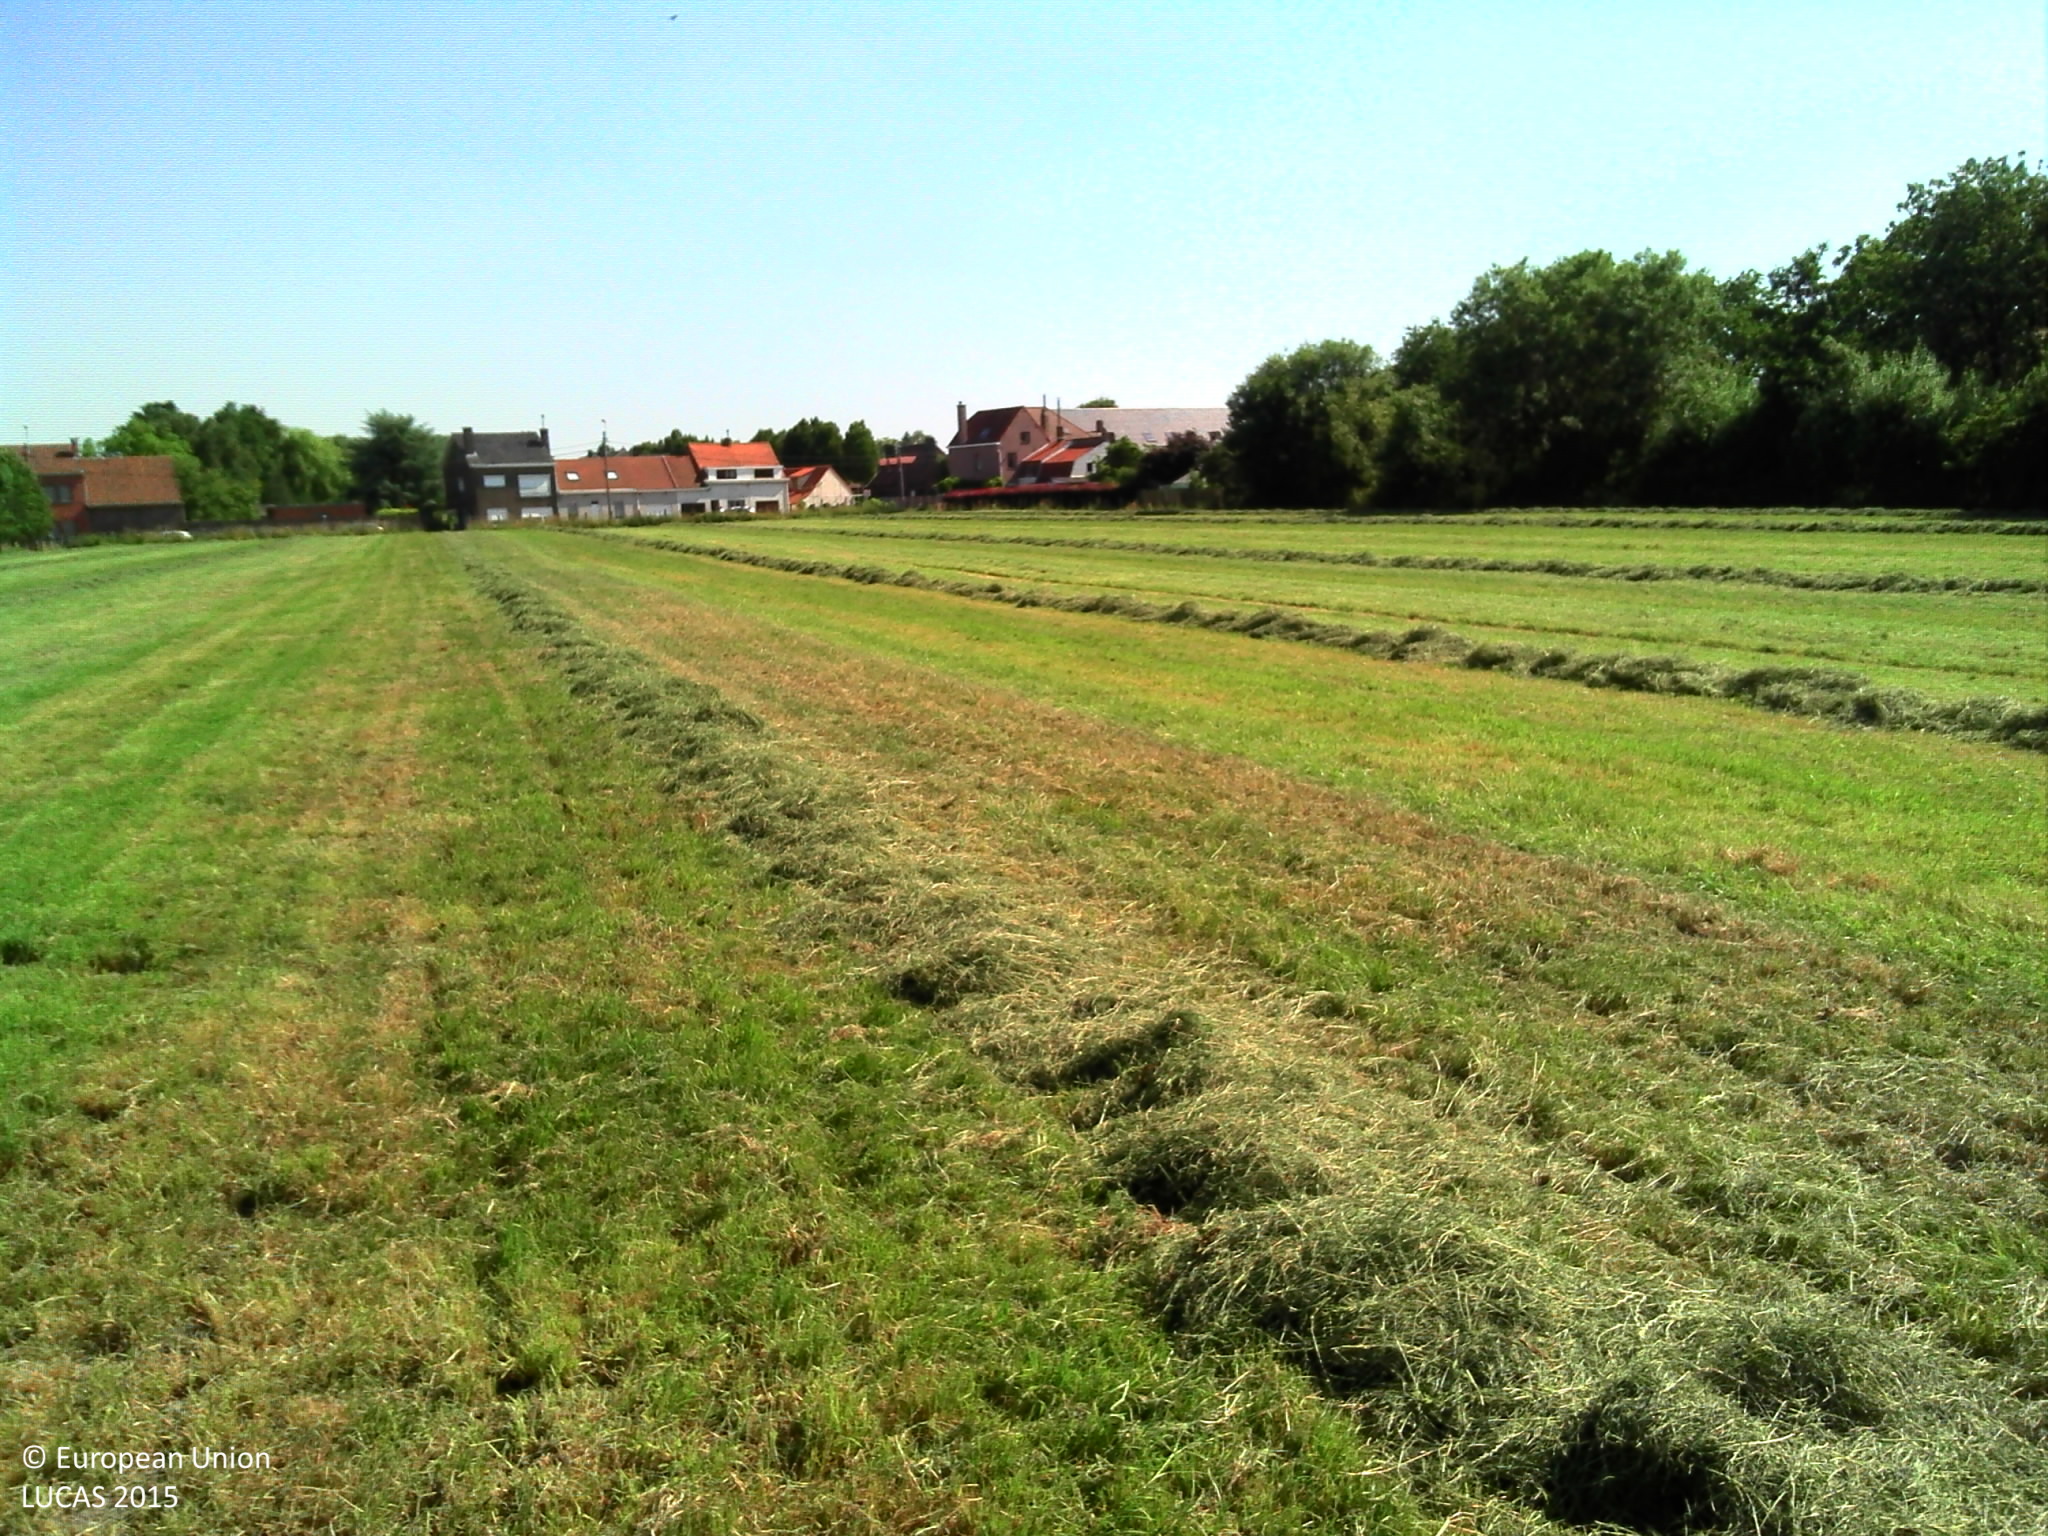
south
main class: Grassland
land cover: Grassland without tree/shrub cover
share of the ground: > 75 %
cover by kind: herbaceous plants 100 %
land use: Agriculture (excluding fallow land and kitchen gardens)
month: June
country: BE
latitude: 51.1262
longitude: 3.6630
